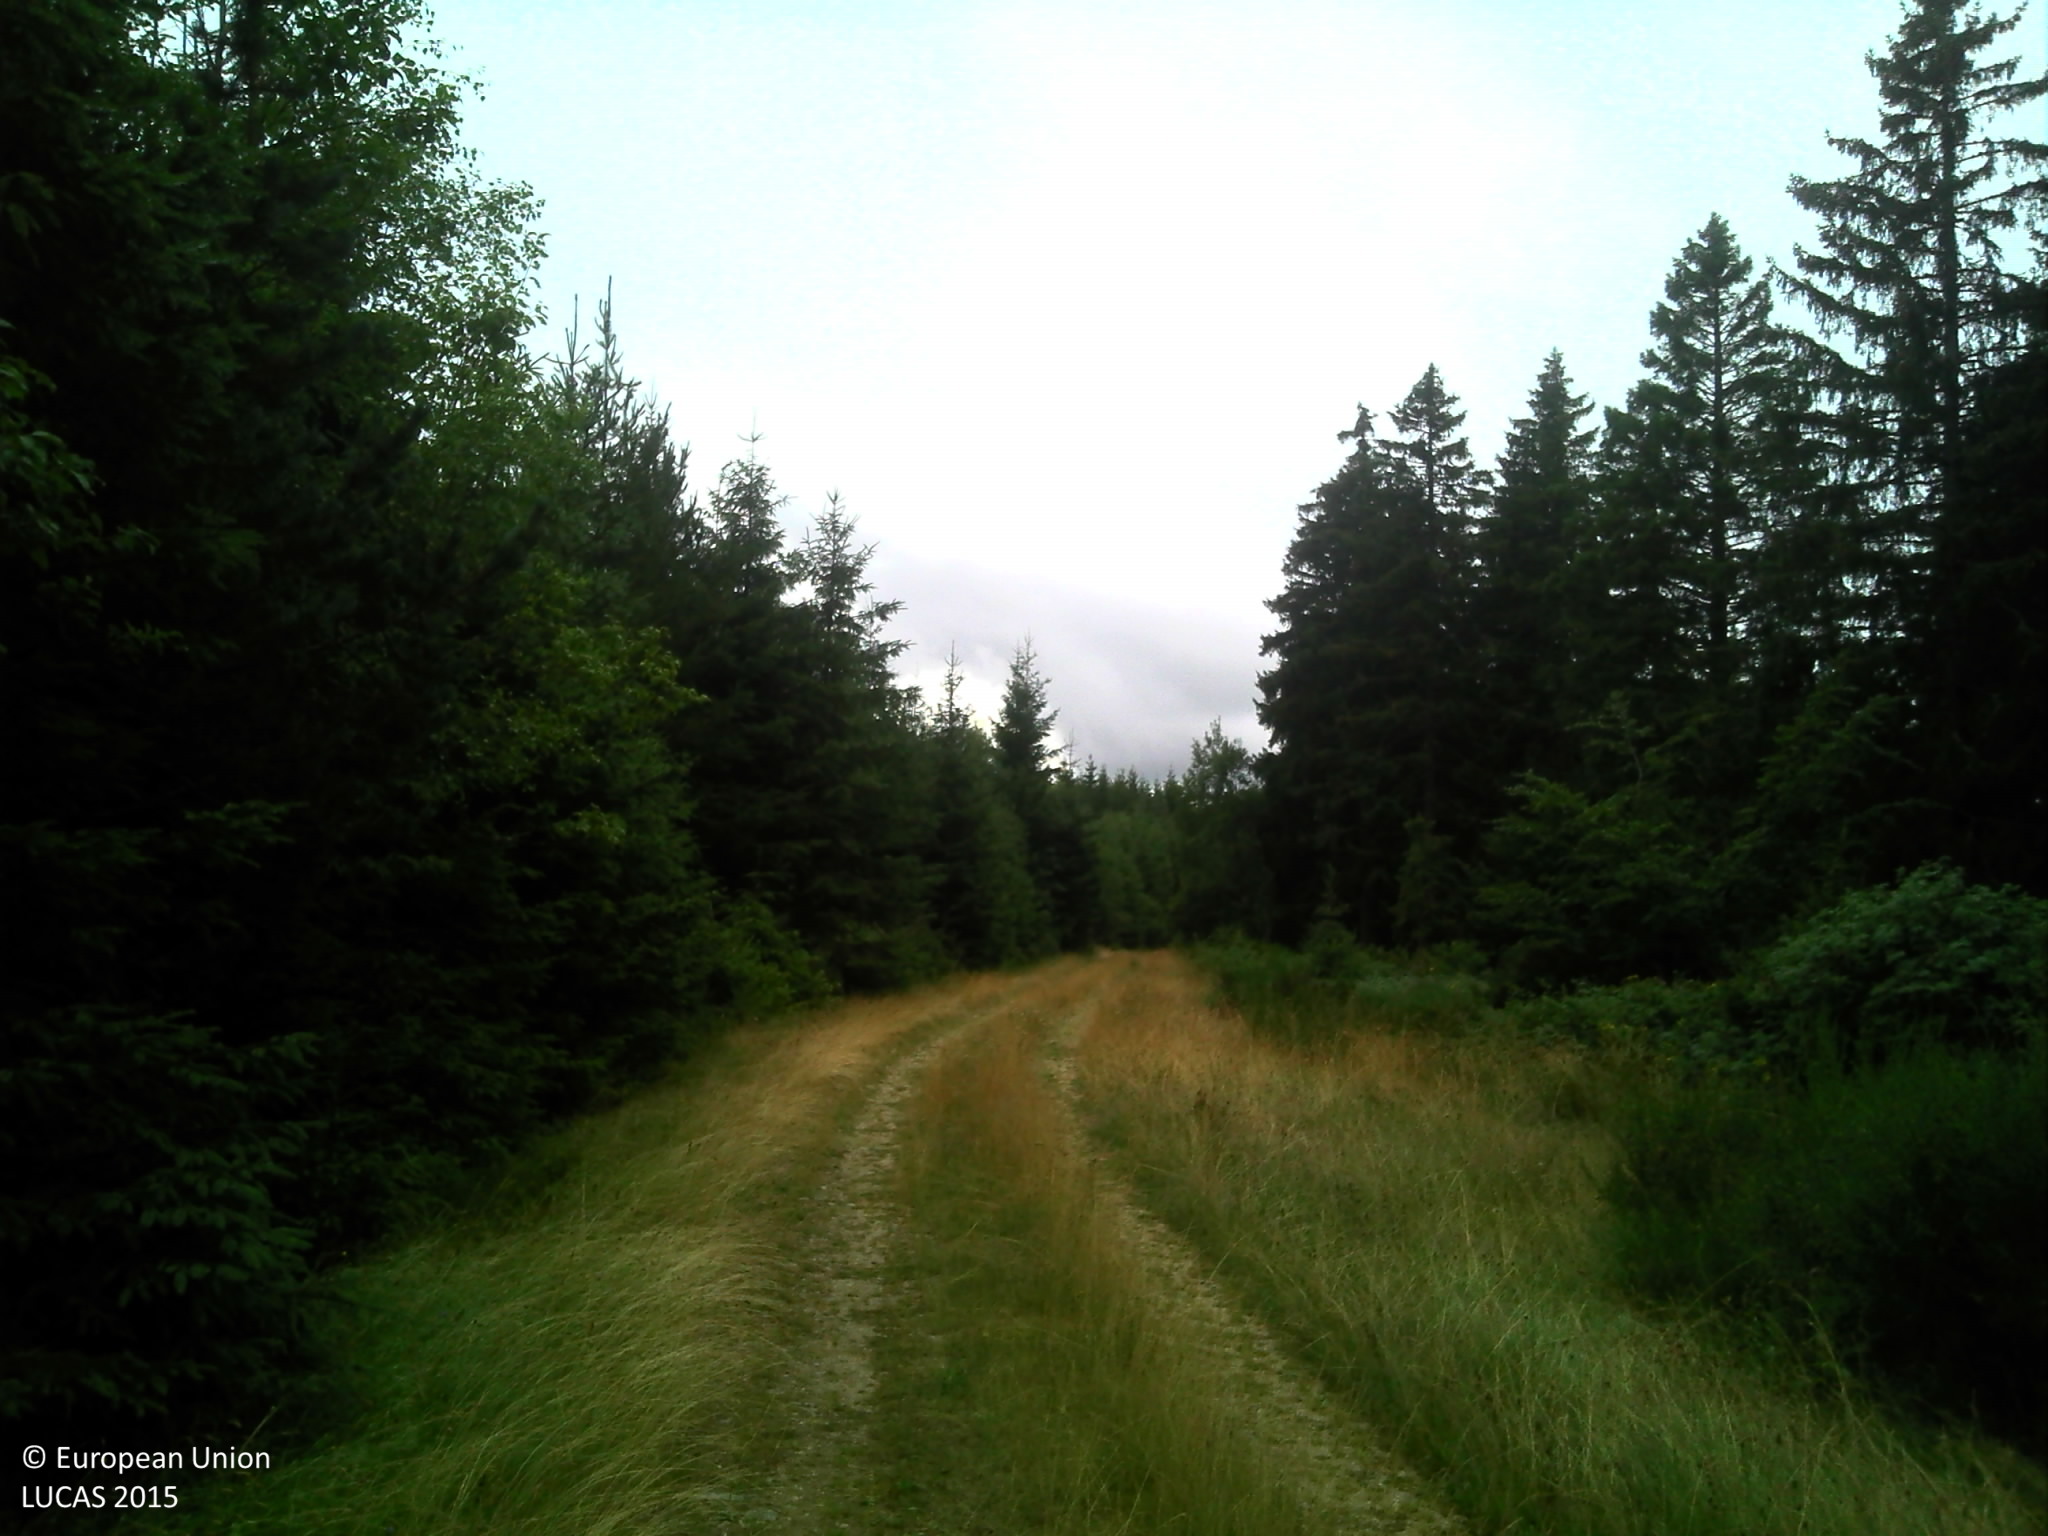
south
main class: Woodland
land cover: Spruce dominated coniferous woodland
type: alpine coniferous forest
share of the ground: > 75 %
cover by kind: coniferous forest trees 95 %, broadleaved forest trees 5 %
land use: Forestry
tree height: > 5 m
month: July
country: FR
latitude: 44.7451
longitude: 3.5252
